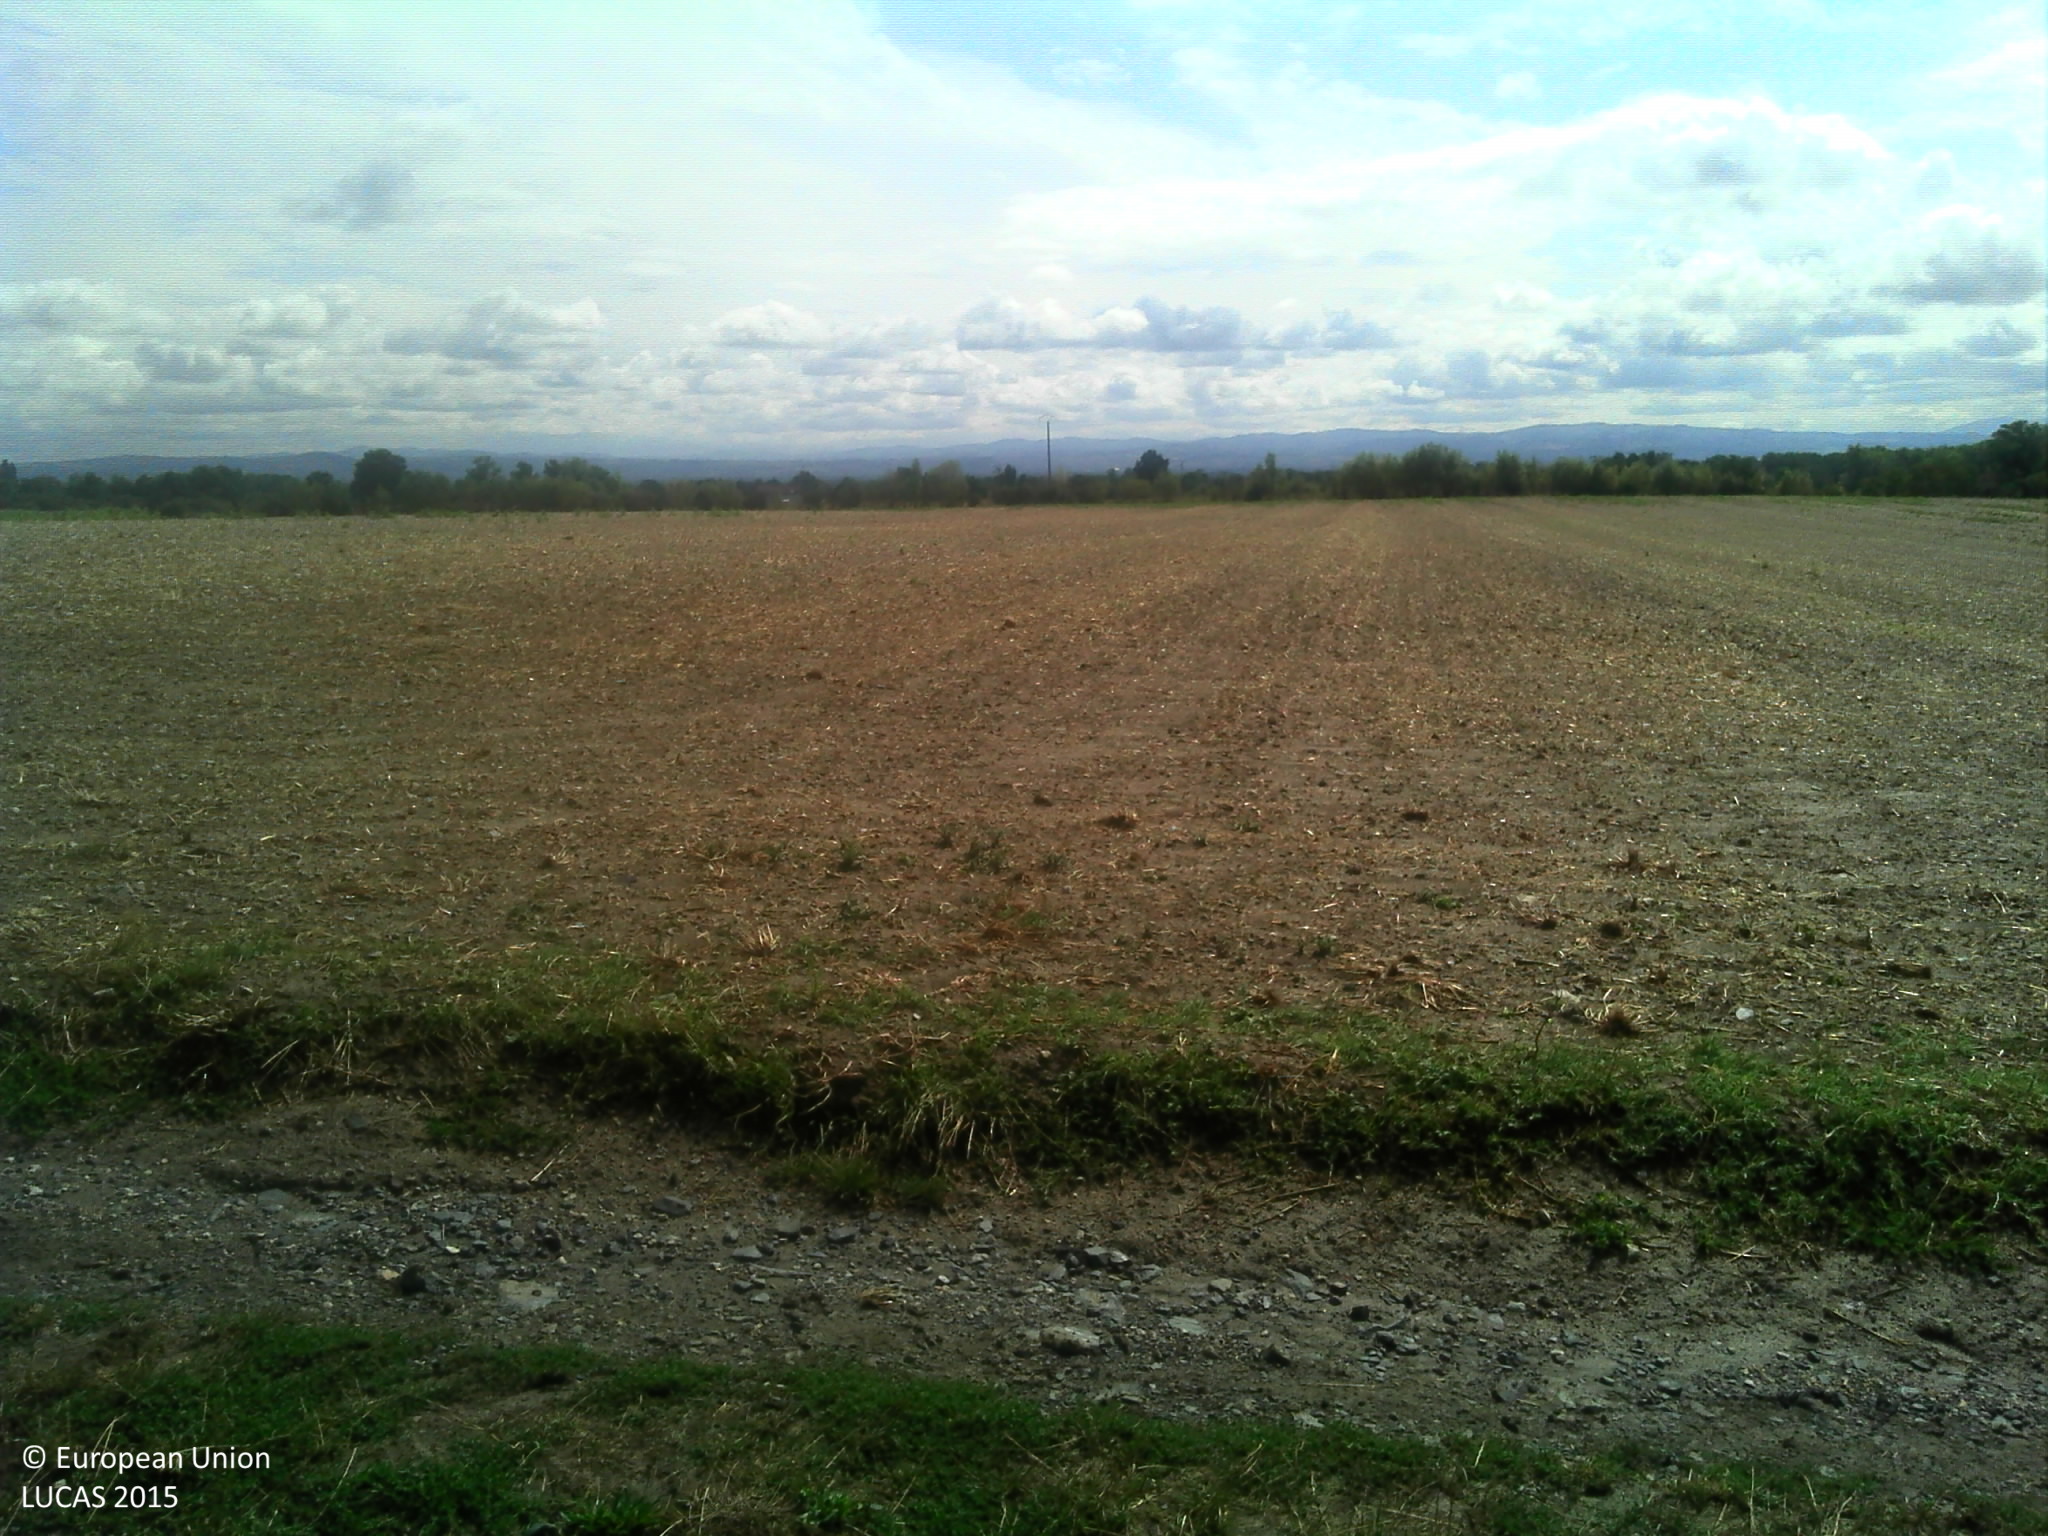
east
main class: Cropland
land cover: Maize
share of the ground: > 75 %
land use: Agriculture (excluding fallow land and kitchen gardens)
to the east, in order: Maize; Tracks; Other bare soil; Grass margins; Managed hedges; Fences; Temporary grasslands
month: August
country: FR
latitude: 45.5934
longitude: 4.1191
